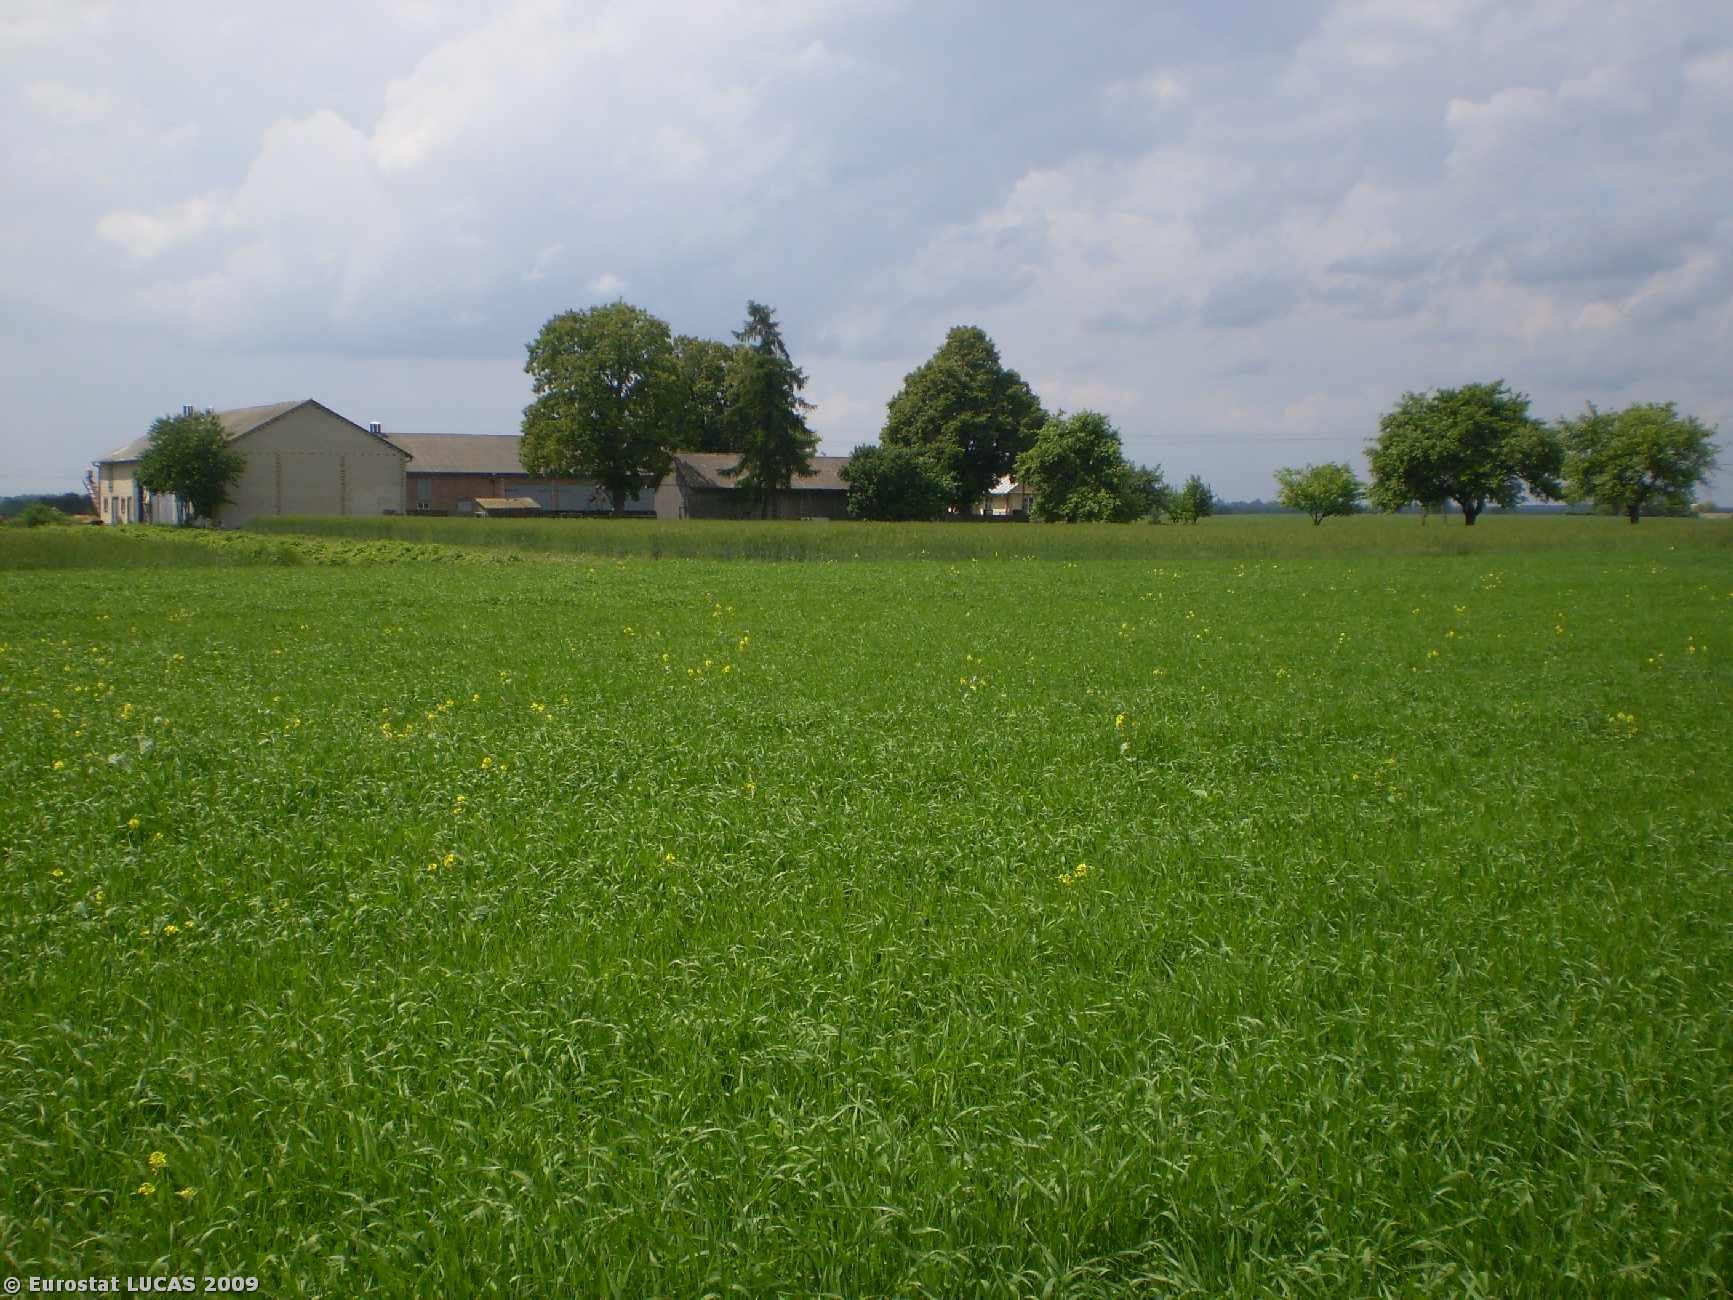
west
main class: Cropland
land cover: Barley
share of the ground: > 75 %
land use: Agriculture (excluding fallow land and kitchen gardens)
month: June
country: PL
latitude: 51.0889
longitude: 22.3855
